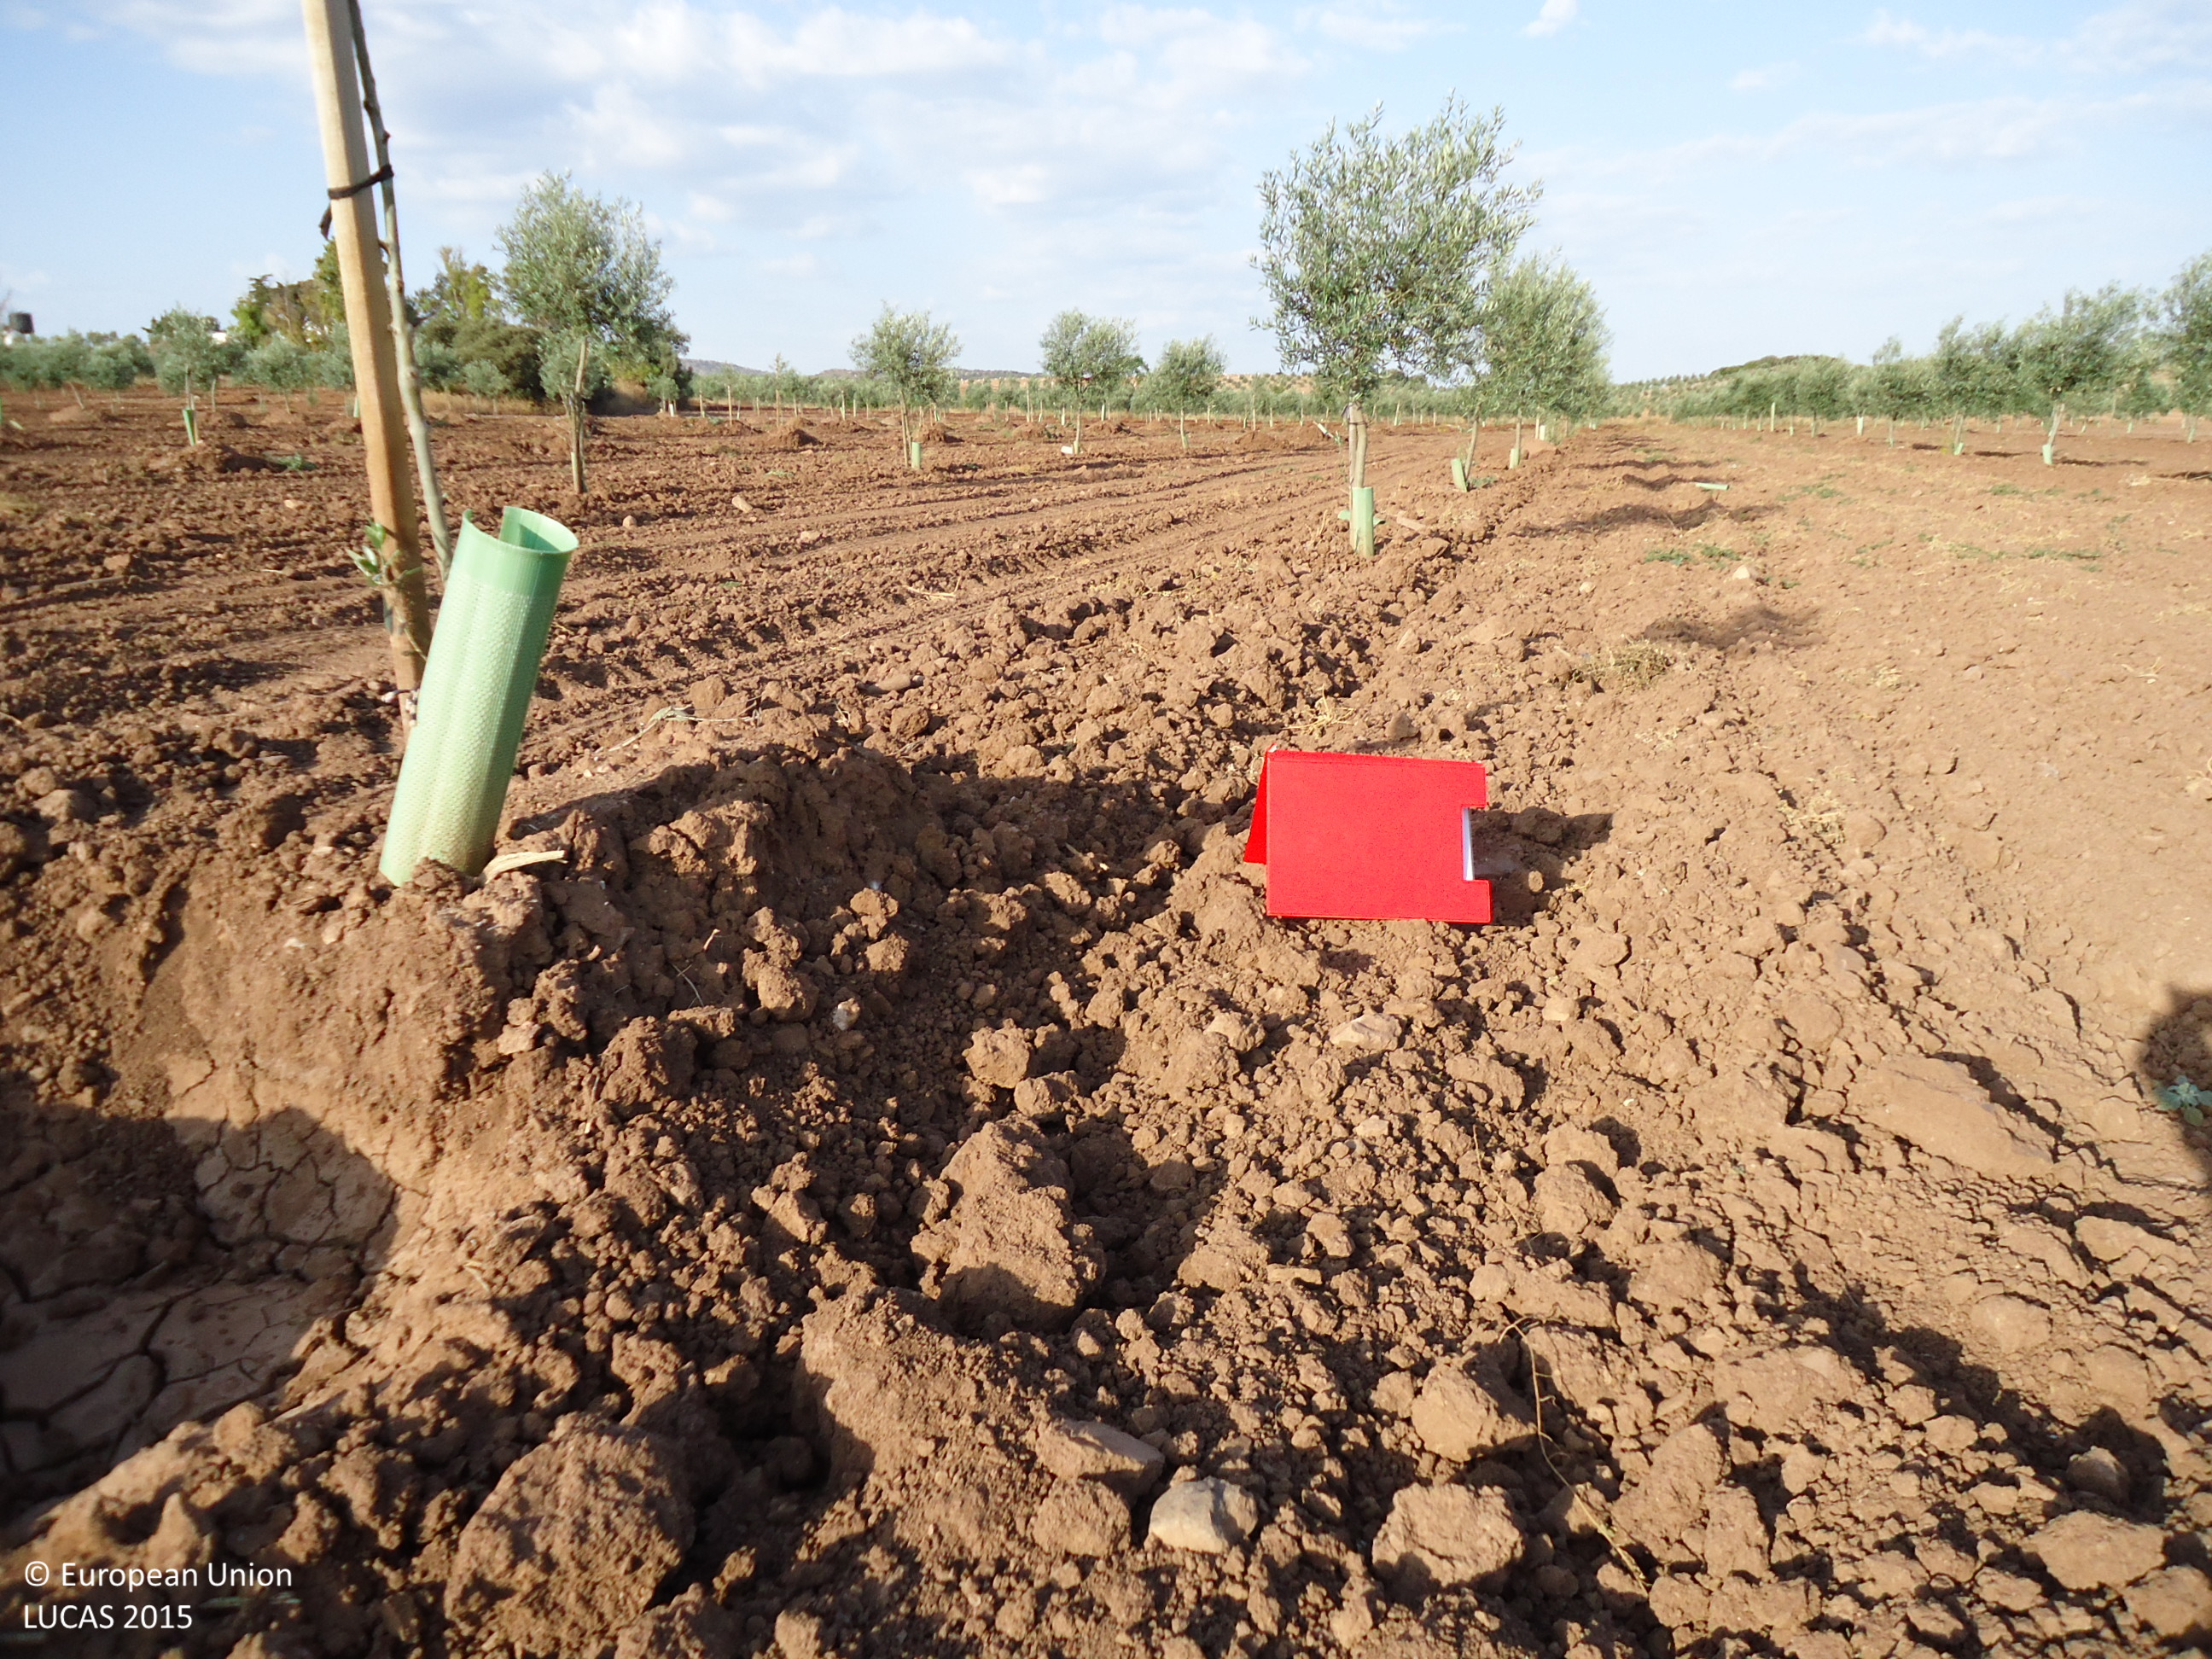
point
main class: Cropland
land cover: Olive groves
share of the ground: 10 - 25 %
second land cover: Other bare soil
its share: > 75 %
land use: Agriculture (excluding fallow land and kitchen gardens)
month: June
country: ES
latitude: 37.0201
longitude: -4.8255
